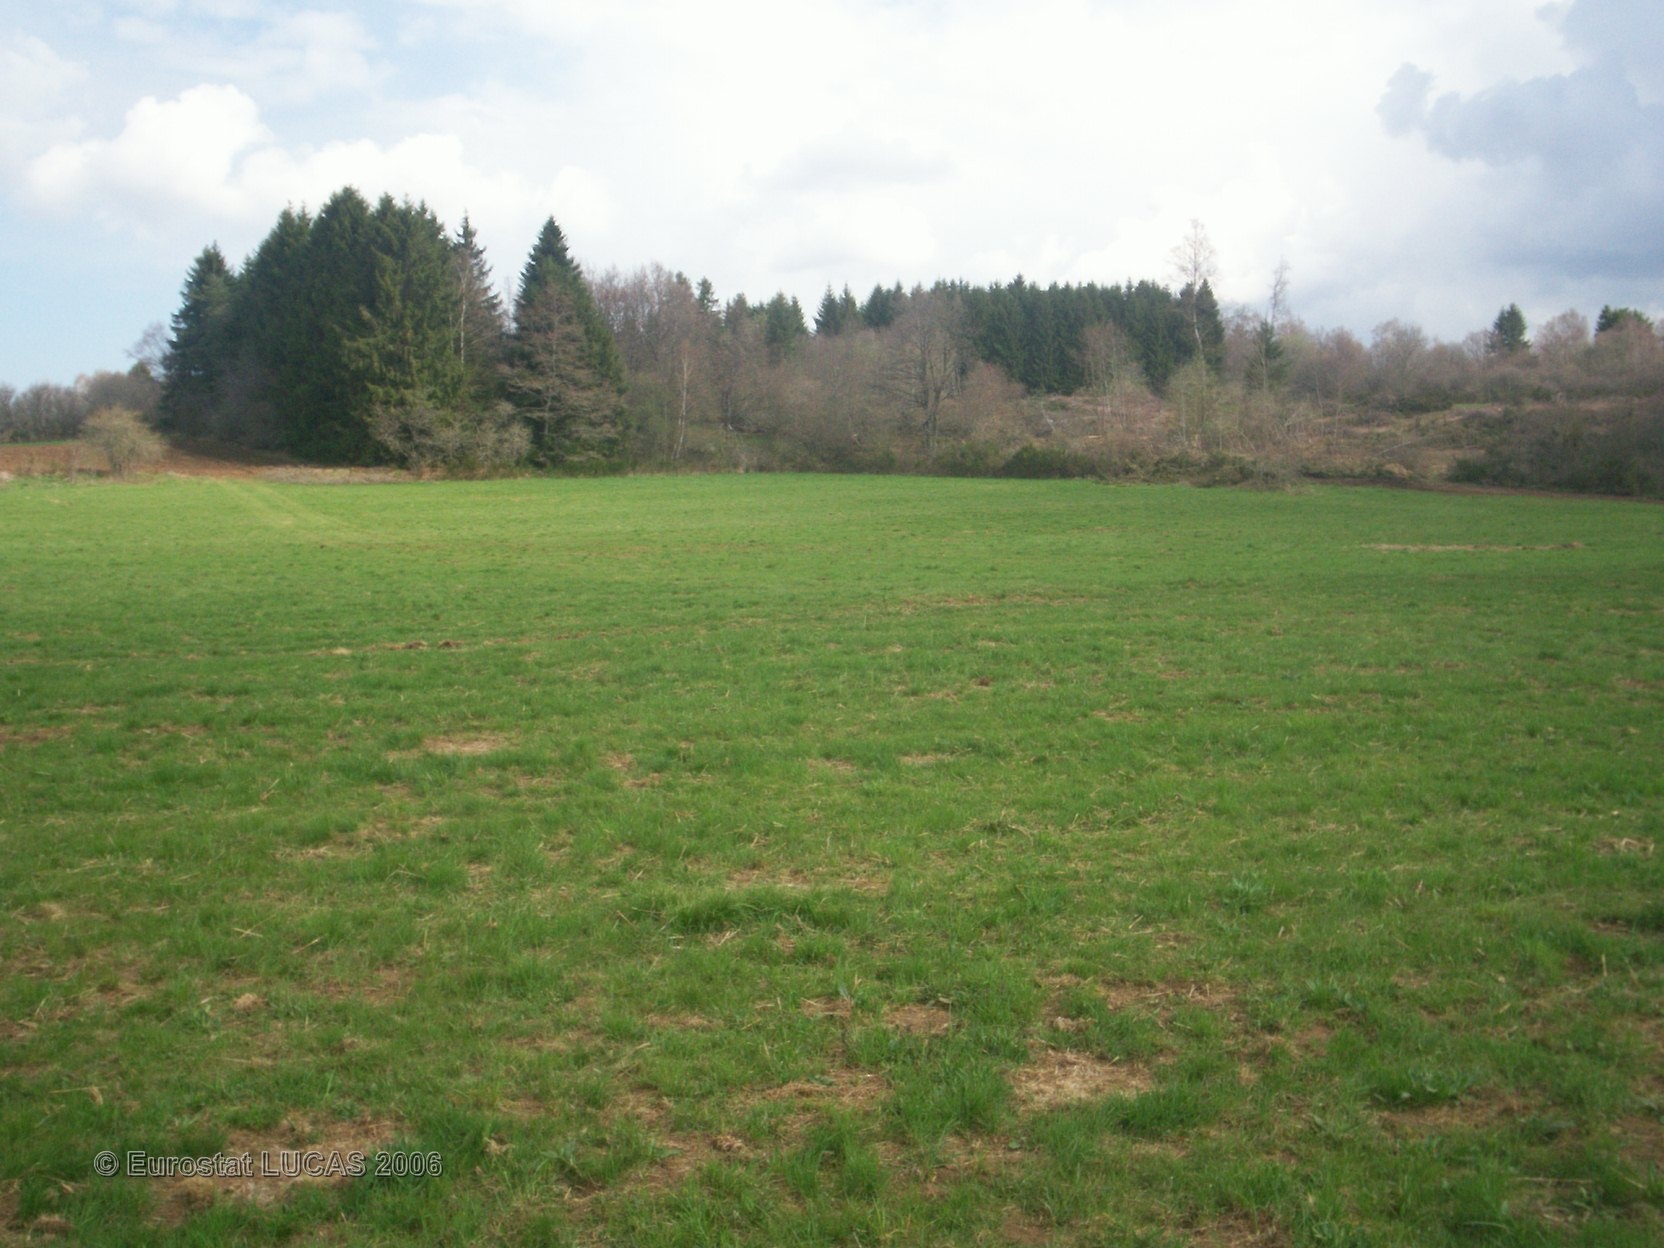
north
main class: Grassland
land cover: Grassland without tree/shrub cover
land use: Agriculture (excluding fallow land and kitchen gardens)
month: April
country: FR
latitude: 45.8459
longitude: 2.9296
